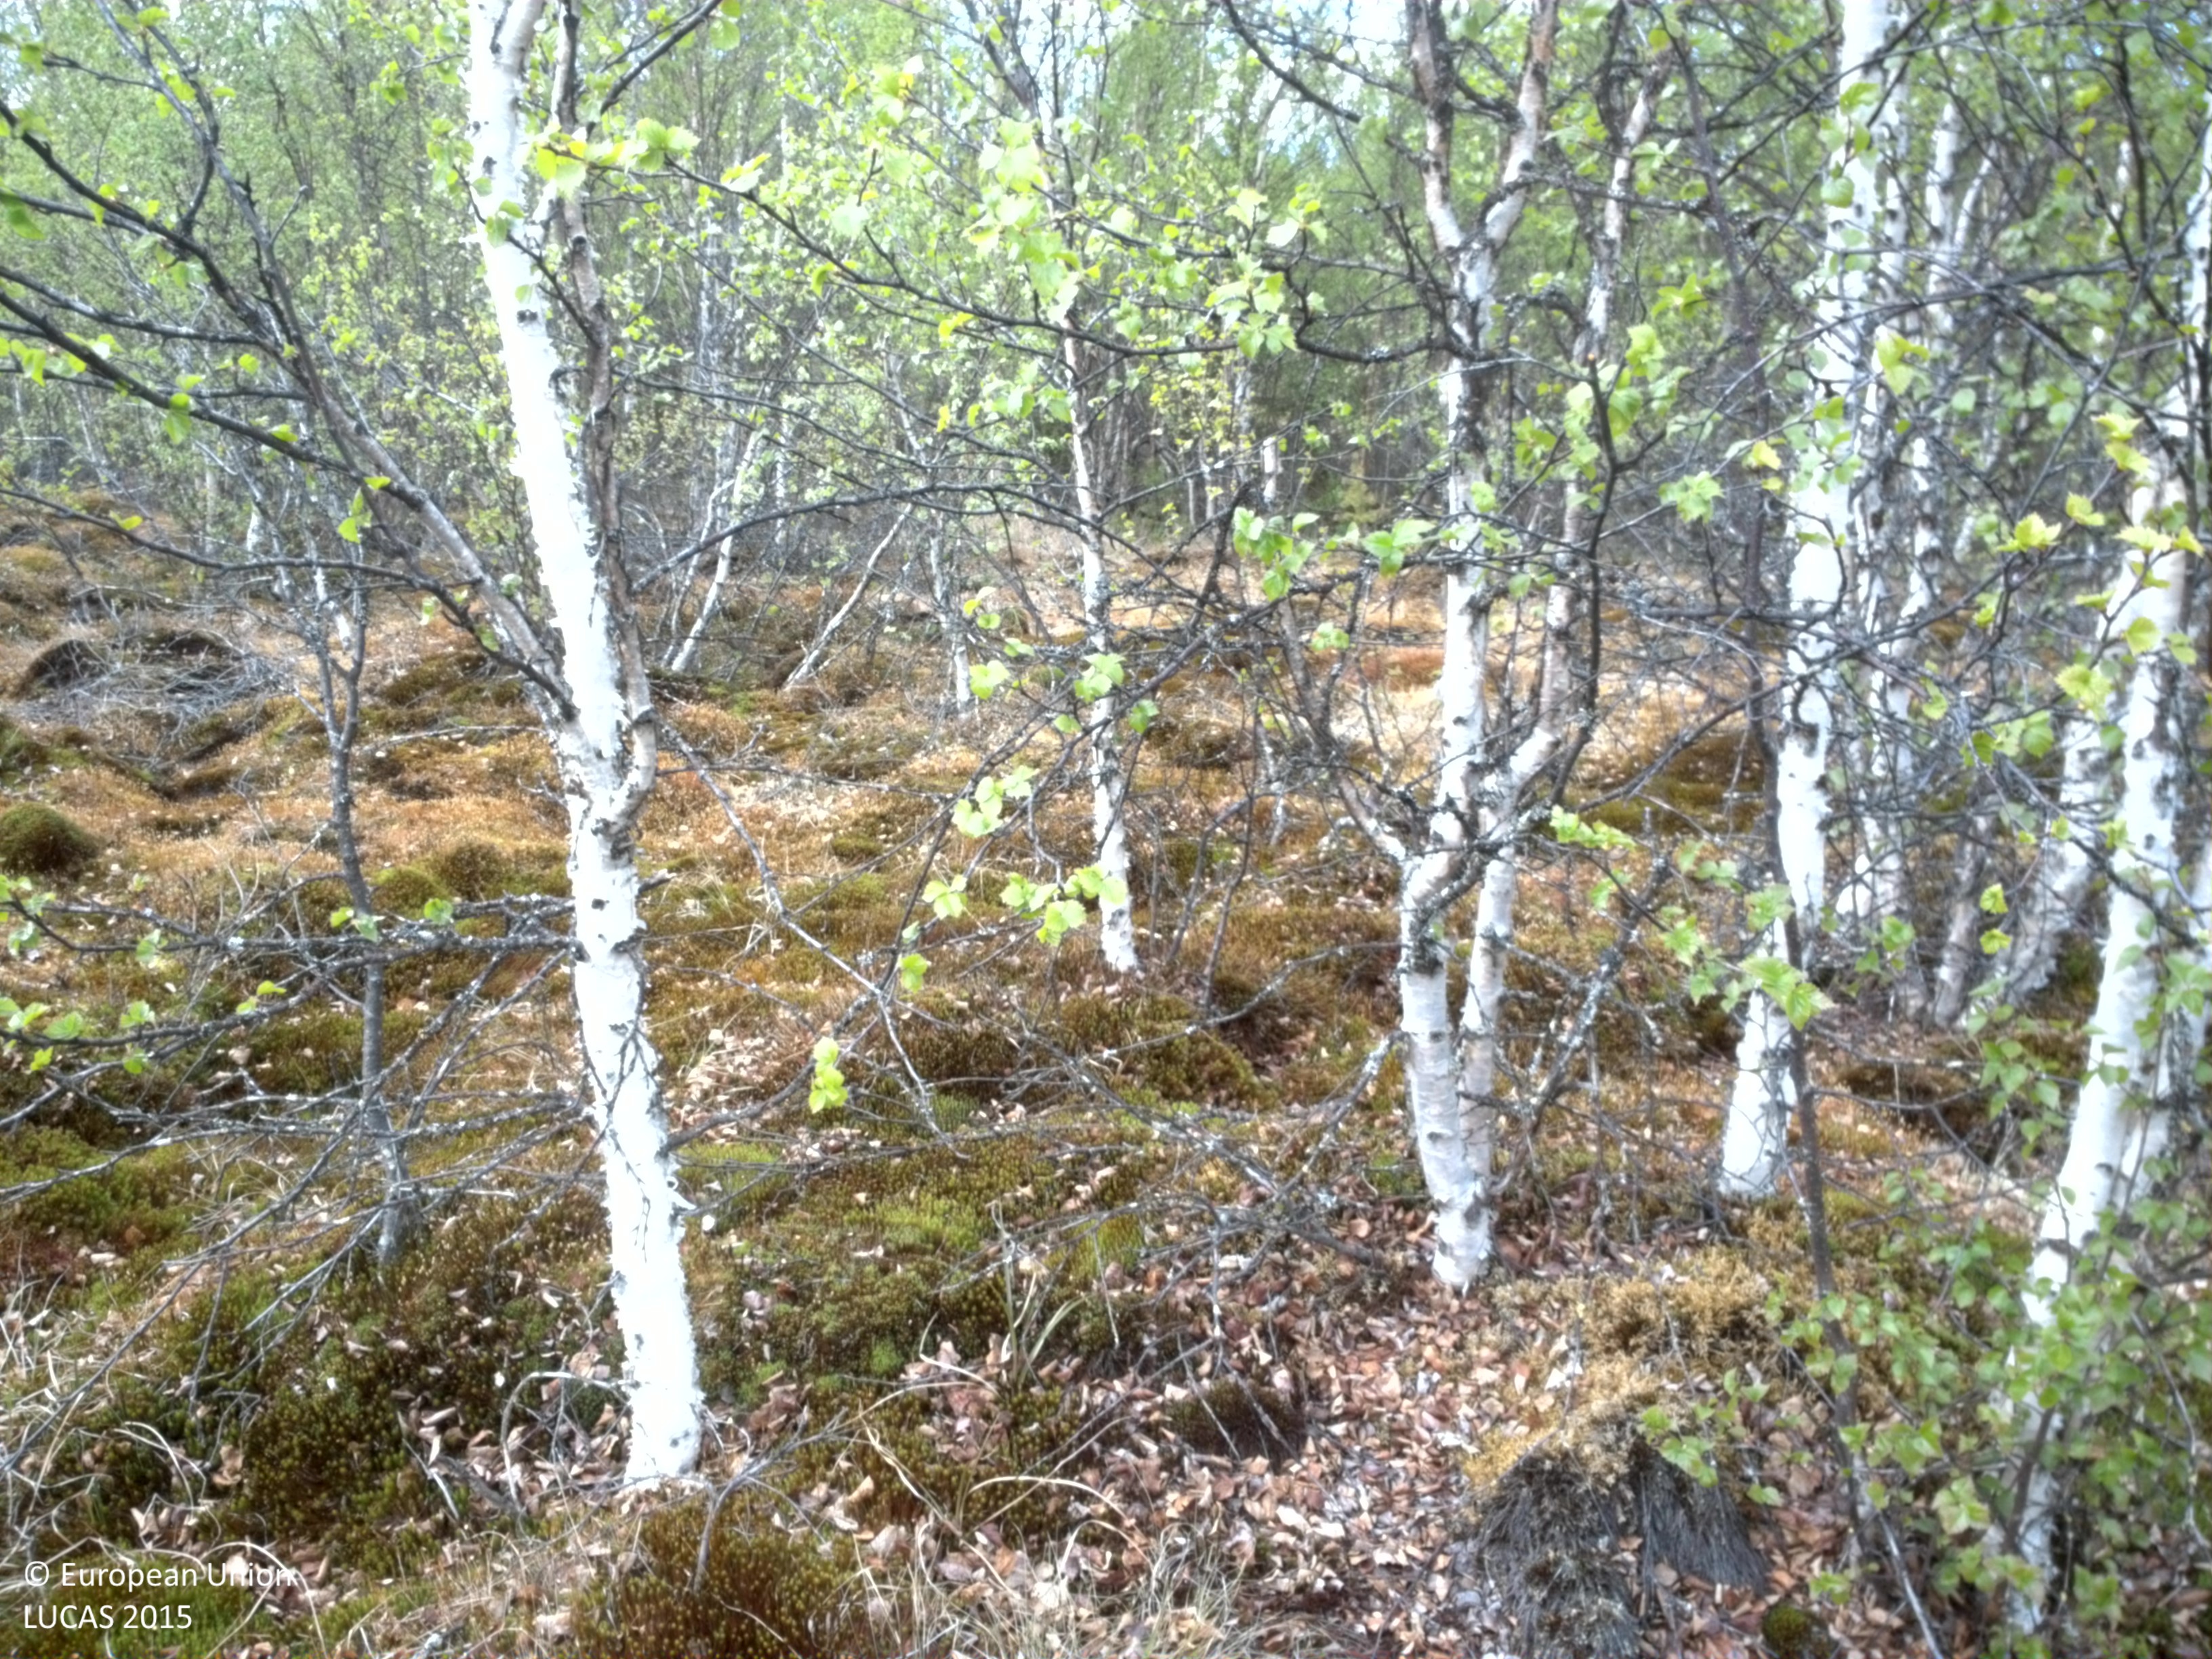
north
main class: Woodland
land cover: Broadleaved woodland
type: boreal forest
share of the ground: 25 - 50 %
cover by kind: lichens and mosses 60 %, broadleaved forest trees 40 %
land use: Forestry
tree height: < 5 m
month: June
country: SE
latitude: 66.9034
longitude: 21.5857
